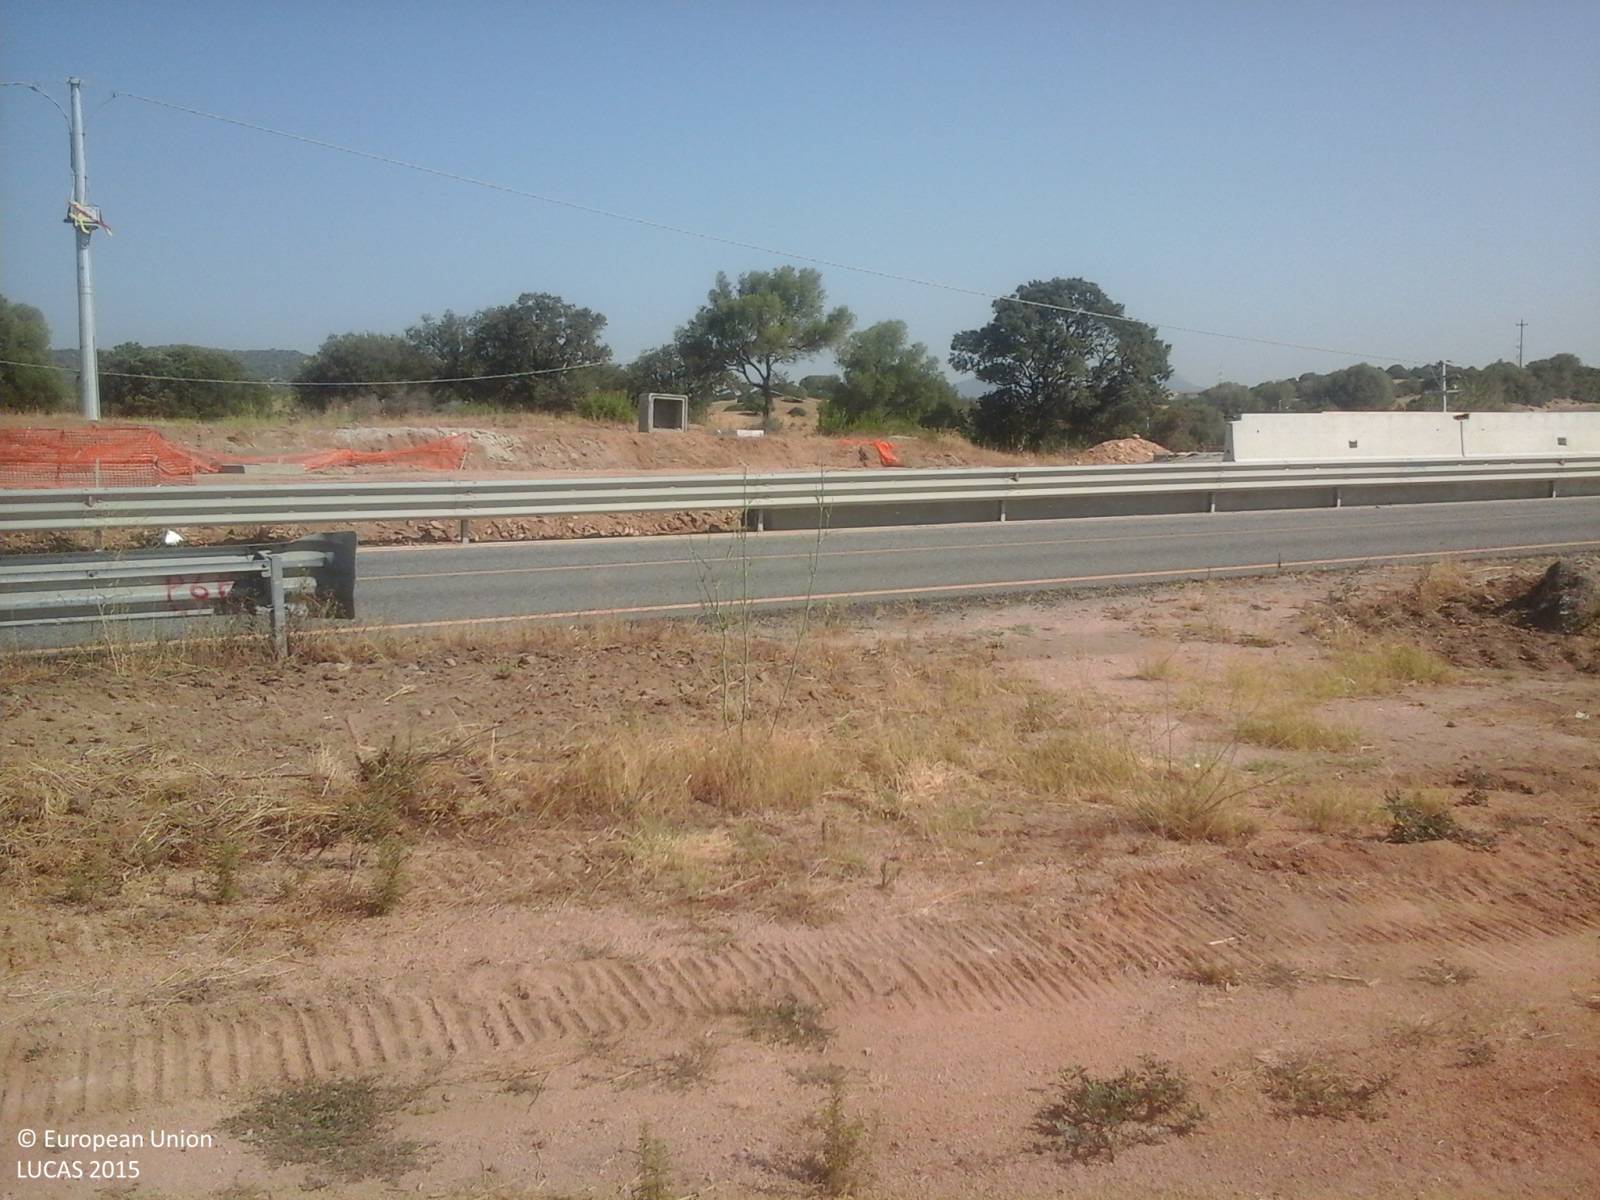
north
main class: Shrubland
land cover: Shrubland with sparse tree cover
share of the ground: > 75 %
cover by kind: shrubs 95 %, broadleaved forest trees 5 %
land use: Agriculture (excluding fallow land and kitchen gardens)
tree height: < 5 m
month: July
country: IT
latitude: 40.8812
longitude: 9.4685
